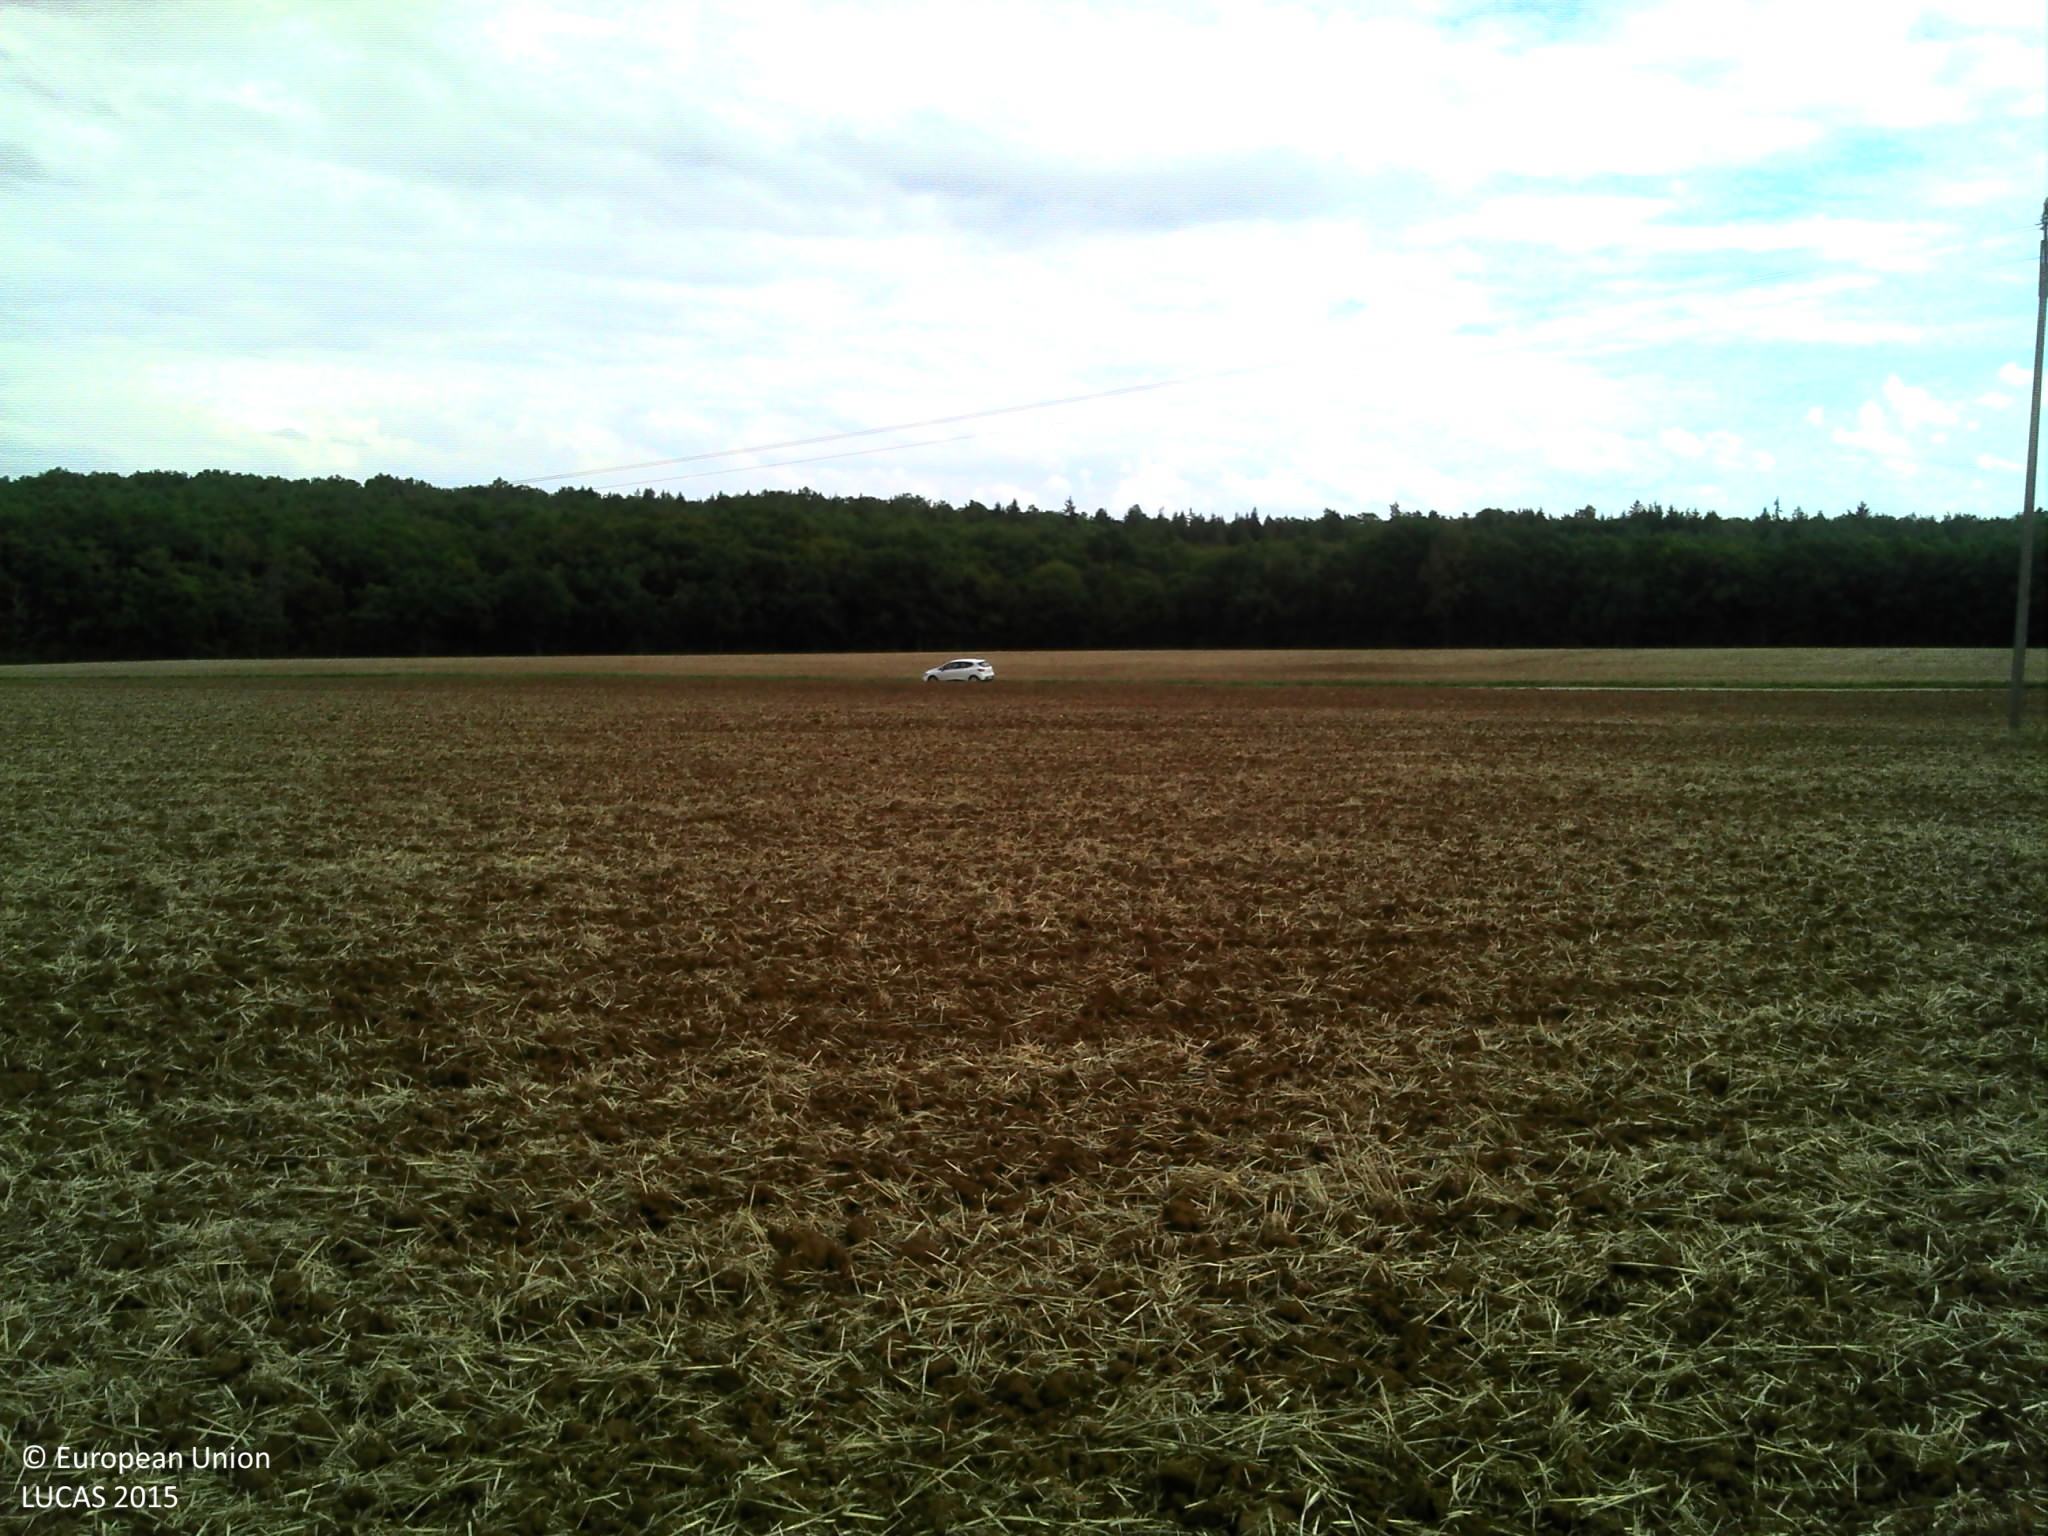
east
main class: Cropland
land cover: Common wheat
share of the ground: > 75 %
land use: Agriculture (excluding fallow land and kitchen gardens)
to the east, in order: Common wheat; Electric lines; Common wheat; Grass margins; Tracks; Grass margins; Common wheat
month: September
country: FR
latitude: 47.8081
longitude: 4.3496
